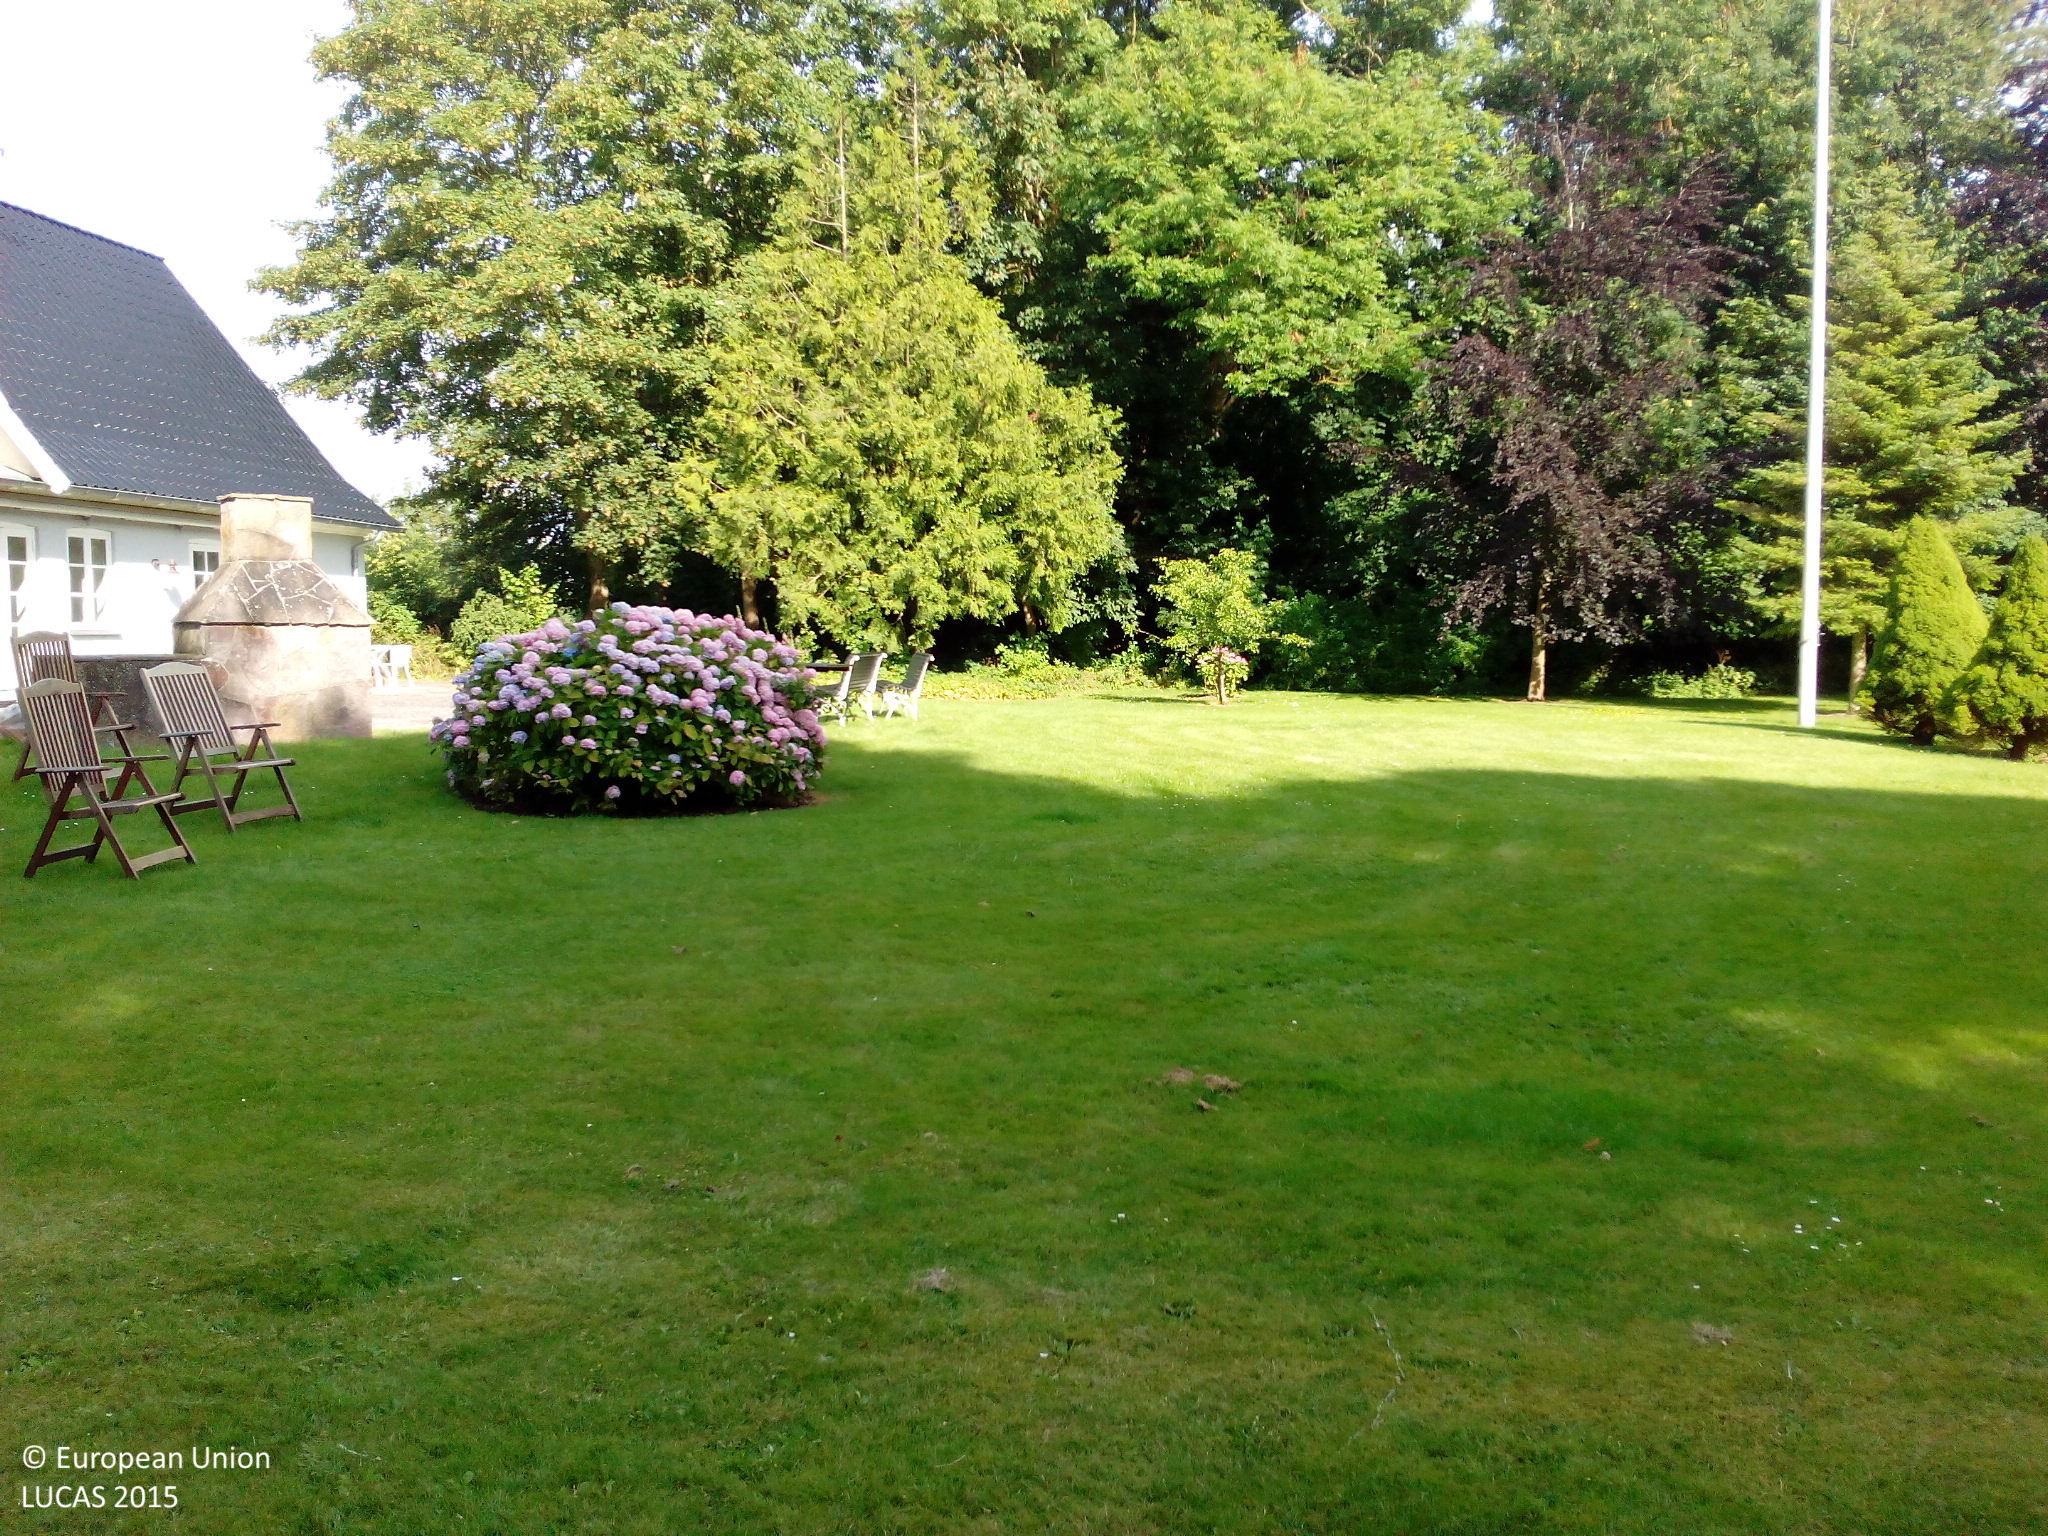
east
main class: Grassland
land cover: Grassland without tree/shrub cover
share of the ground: > 75 %
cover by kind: herbaceous plants 100 %
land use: Residential
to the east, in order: Grassland without tree/shrub cover; Broadleaved woodland; Other mixed woodland; Broadleaved woodland
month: August
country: DK
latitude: 55.6125
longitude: 12.1415
